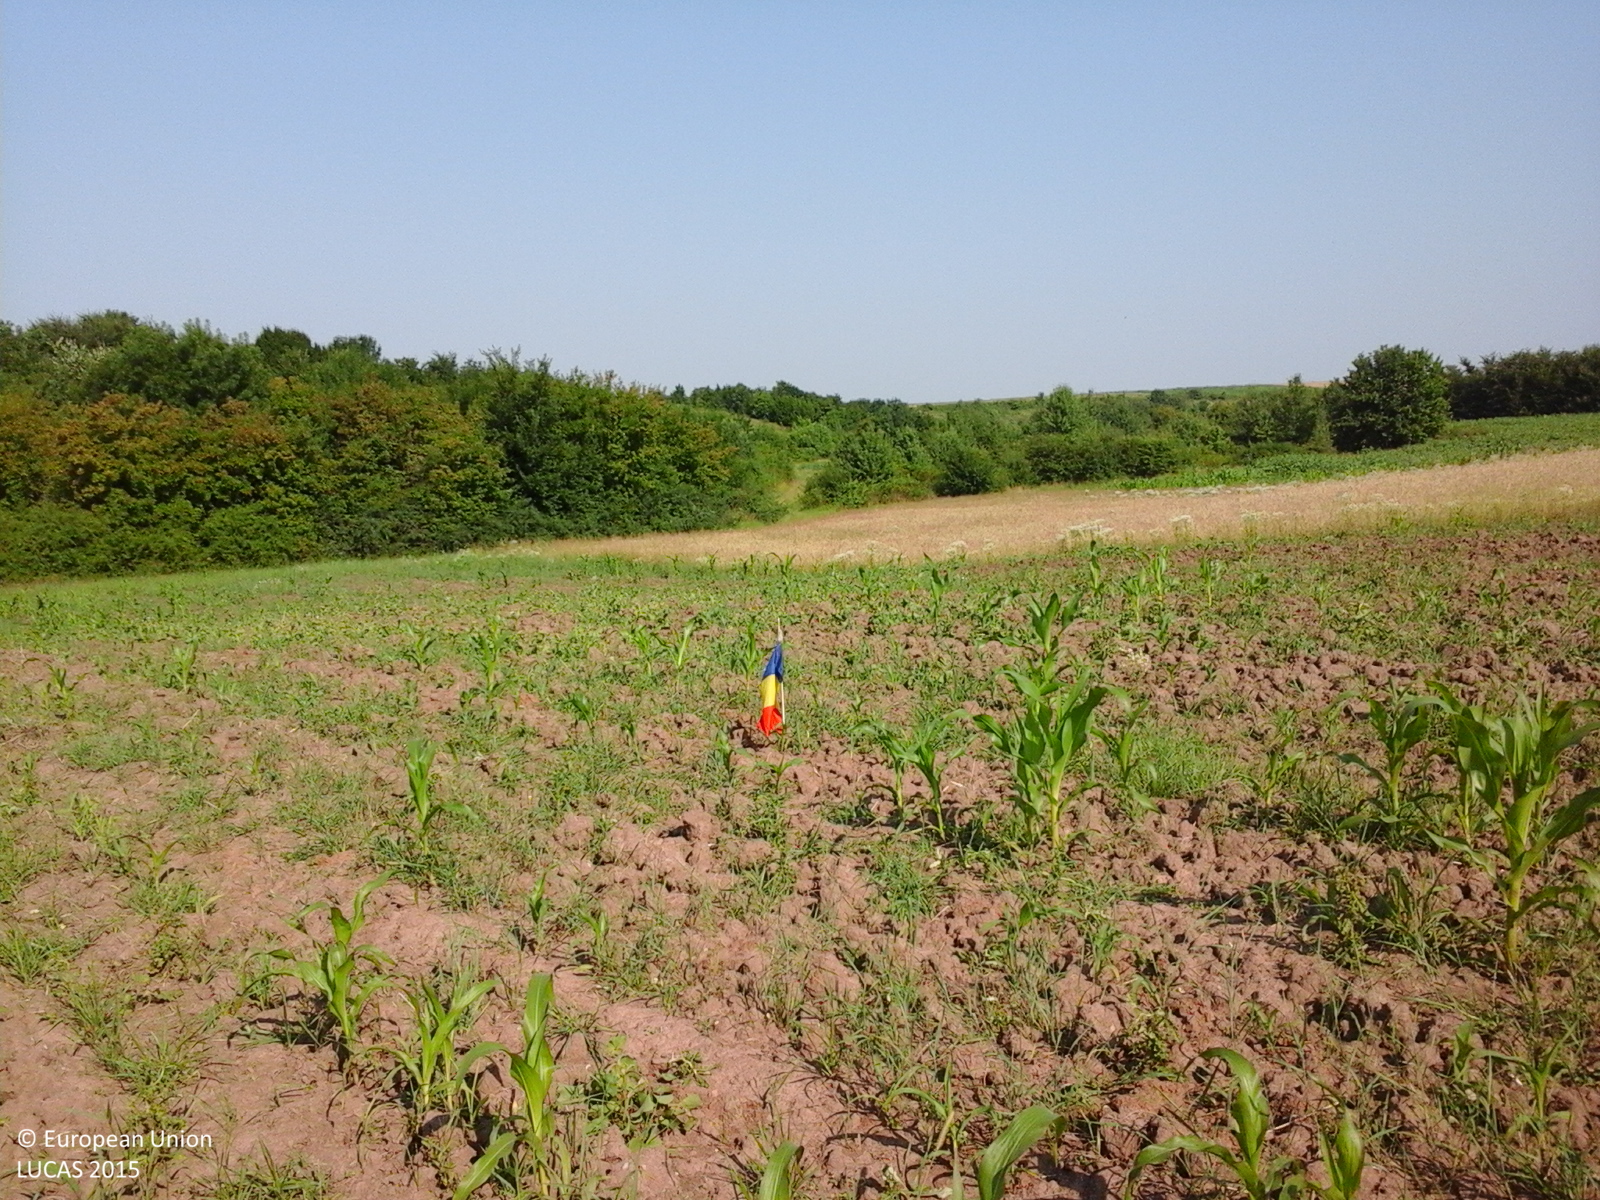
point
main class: Cropland
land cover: Maize
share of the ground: < 10 %
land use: Agriculture (excluding fallow land and kitchen gardens)
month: July
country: RO
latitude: 44.6105
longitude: 24.6028
